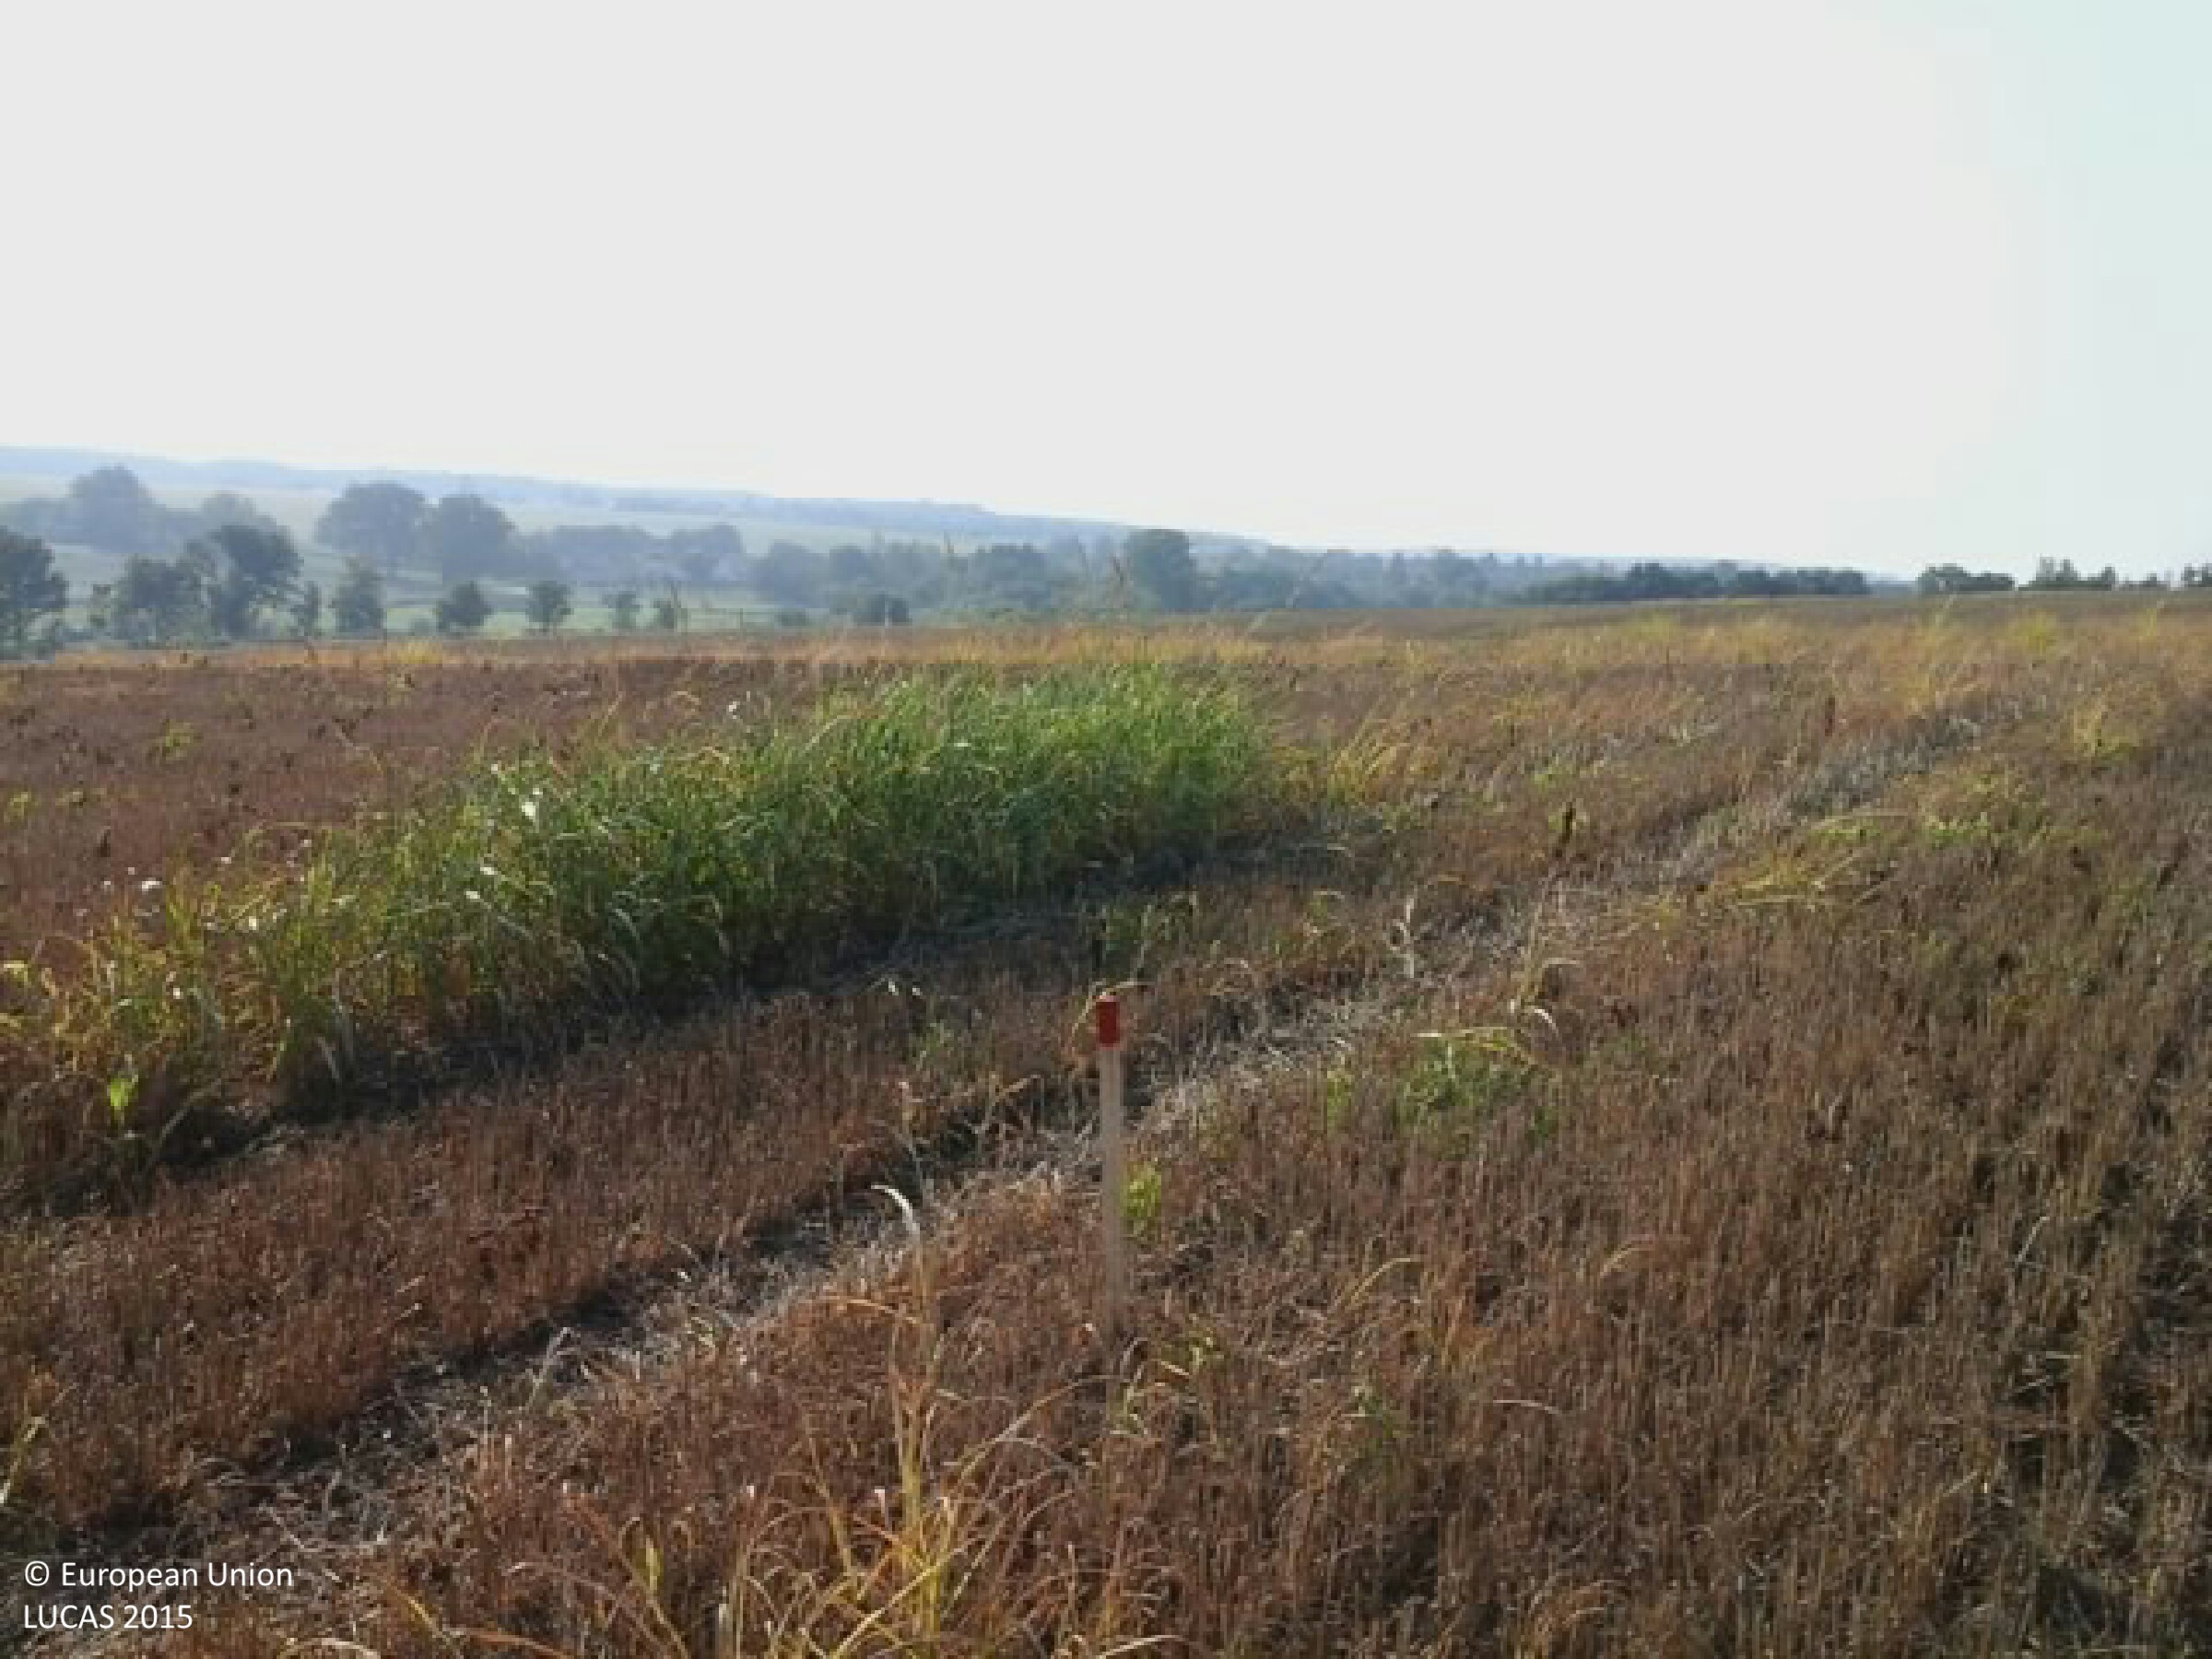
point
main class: Cropland
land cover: Common wheat
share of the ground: > 75 %
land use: Agriculture (excluding fallow land and kitchen gardens)
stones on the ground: < 10 %
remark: Harvested field
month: August
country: HU
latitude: 46.4560
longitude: 17.9098
